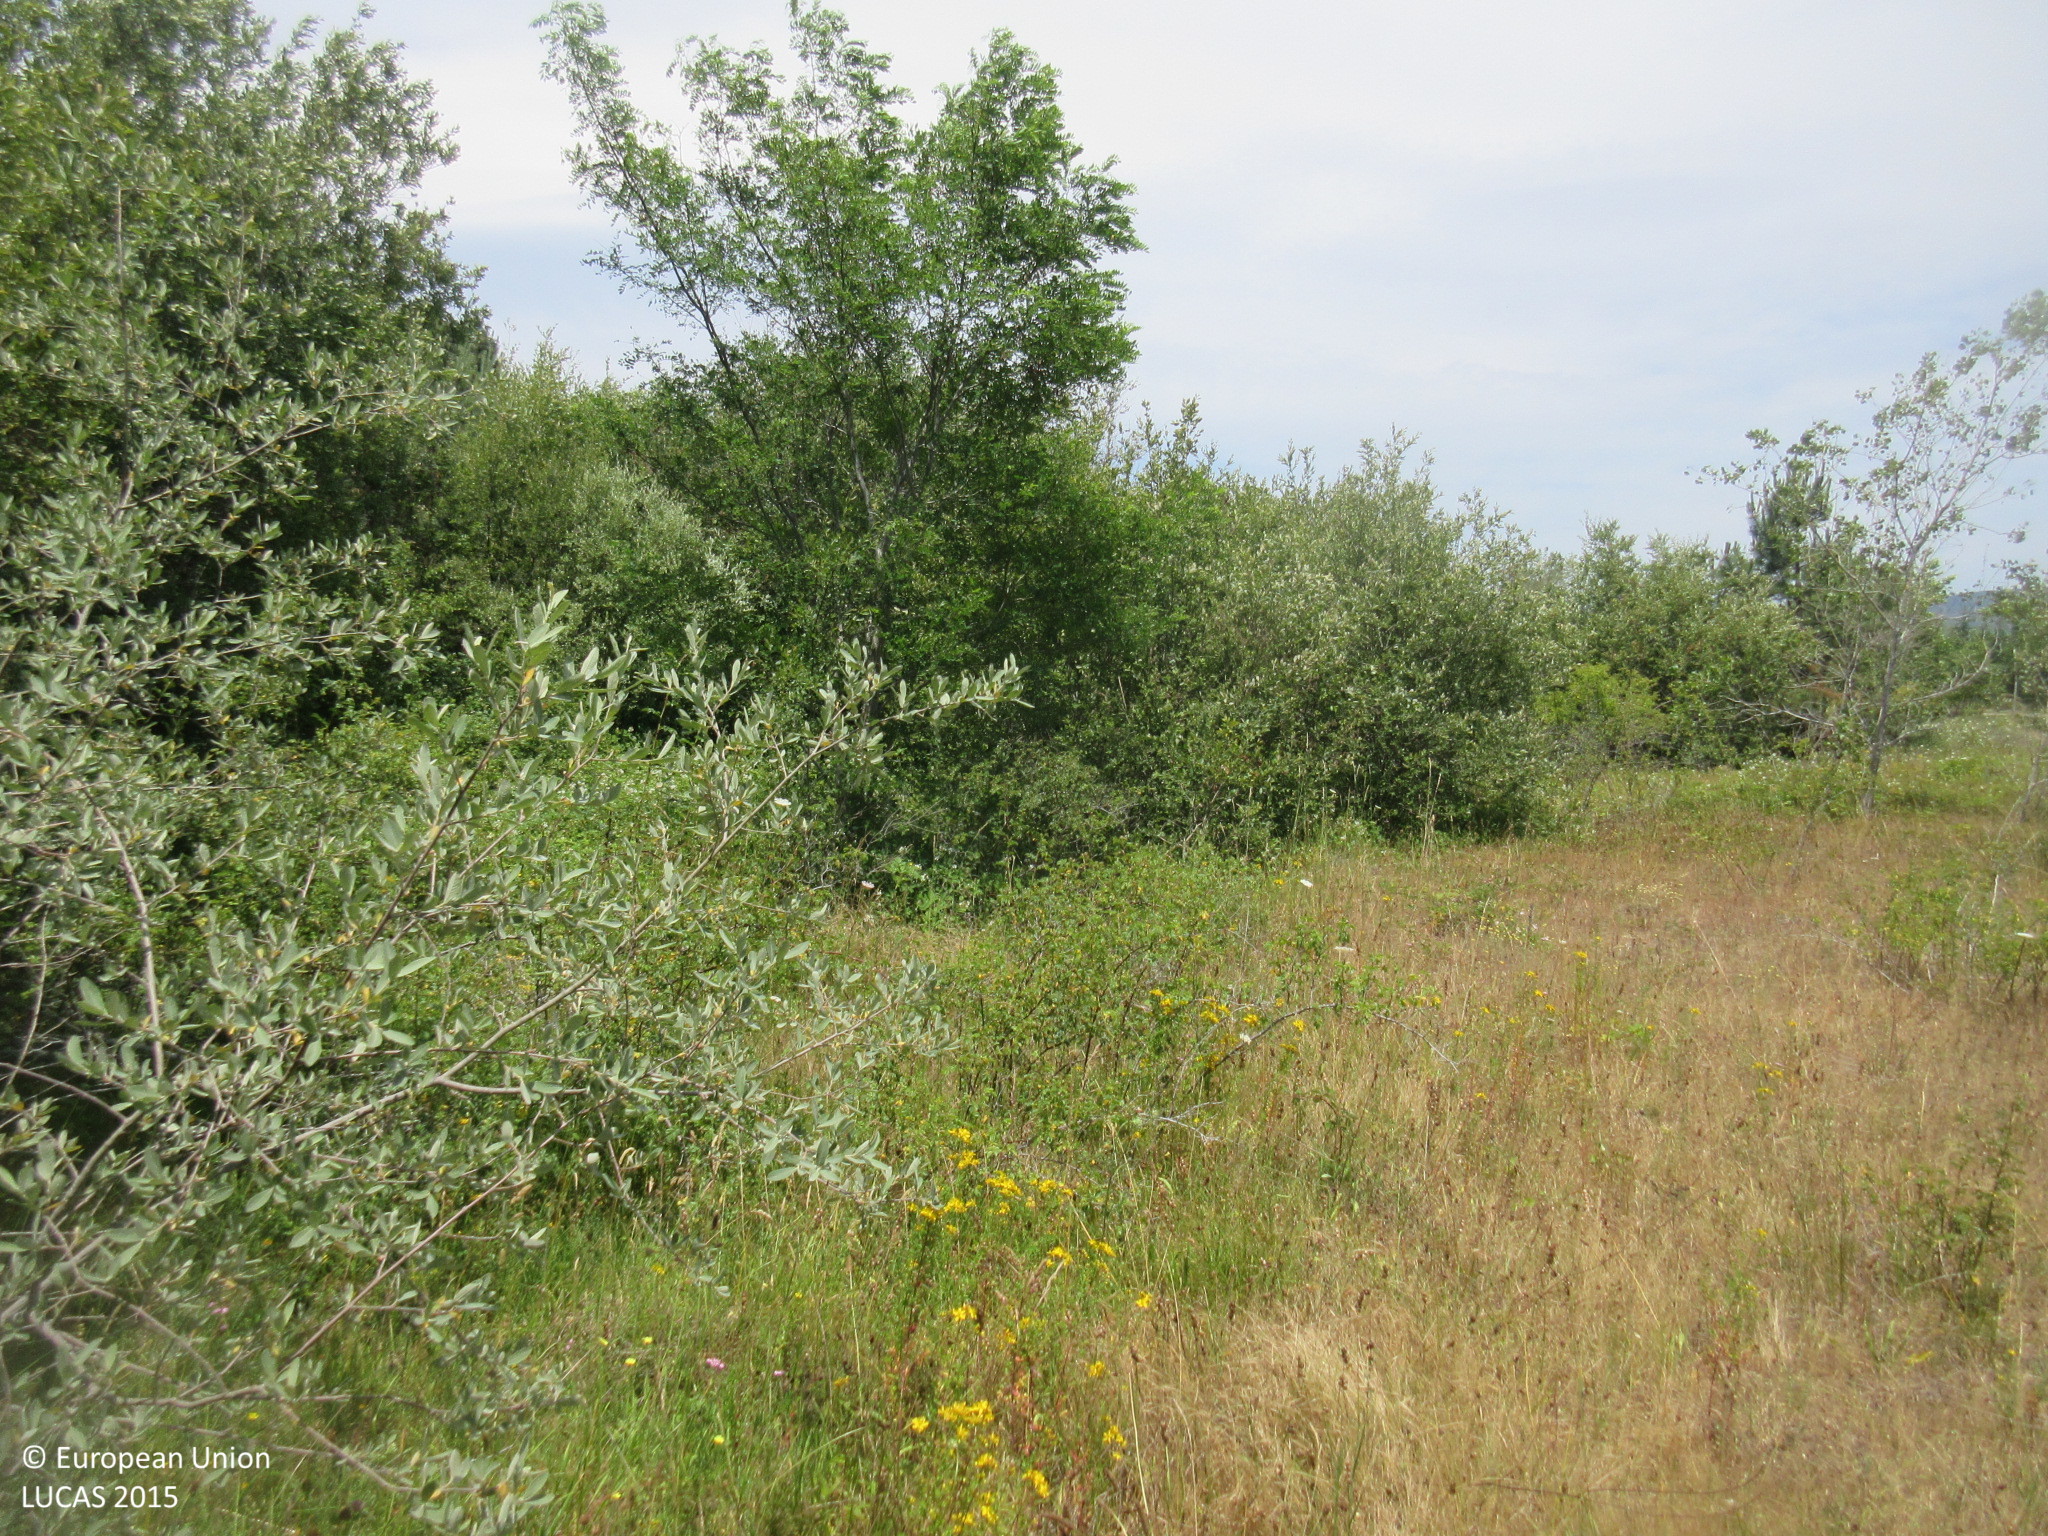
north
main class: Woodland
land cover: Broadleaved woodland
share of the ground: 50 - 75 %
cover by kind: broadleaved forest trees 70 %, shrubs 30 %
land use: Semi-natural and natural areas not in use
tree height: < 5 m
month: July
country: ES
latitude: 43.0012
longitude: -3.9454
